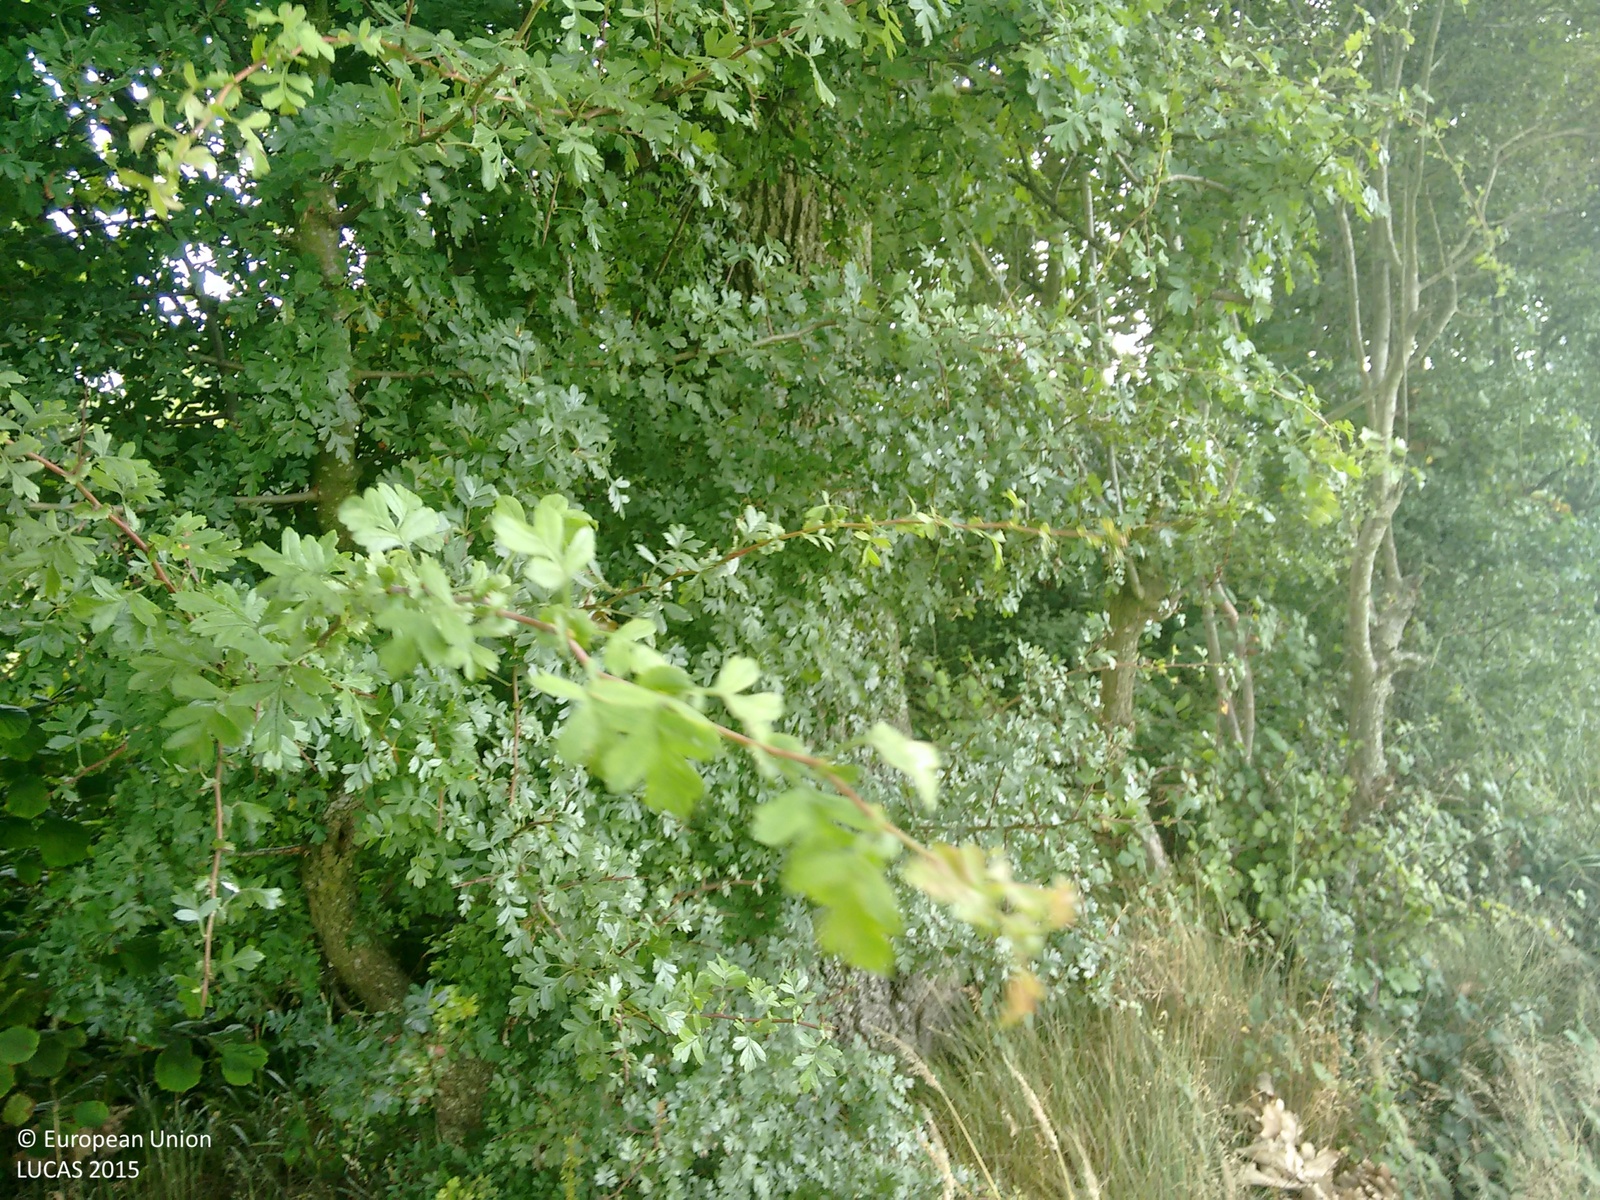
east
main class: Woodland
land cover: Broadleaved woodland
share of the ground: > 75 %
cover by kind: broadleaved forest trees 100 %
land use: Agriculture (excluding fallow land and kitchen gardens)
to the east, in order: Broadleaved woodland; Fences; Grassland without tree/shrub cover; Fences; Grassland without tree/shrub cover; Artificial constructions in urban areas; Grassland without tree/shrub cover
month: July
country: GB
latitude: 51.5192
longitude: -2.4451
